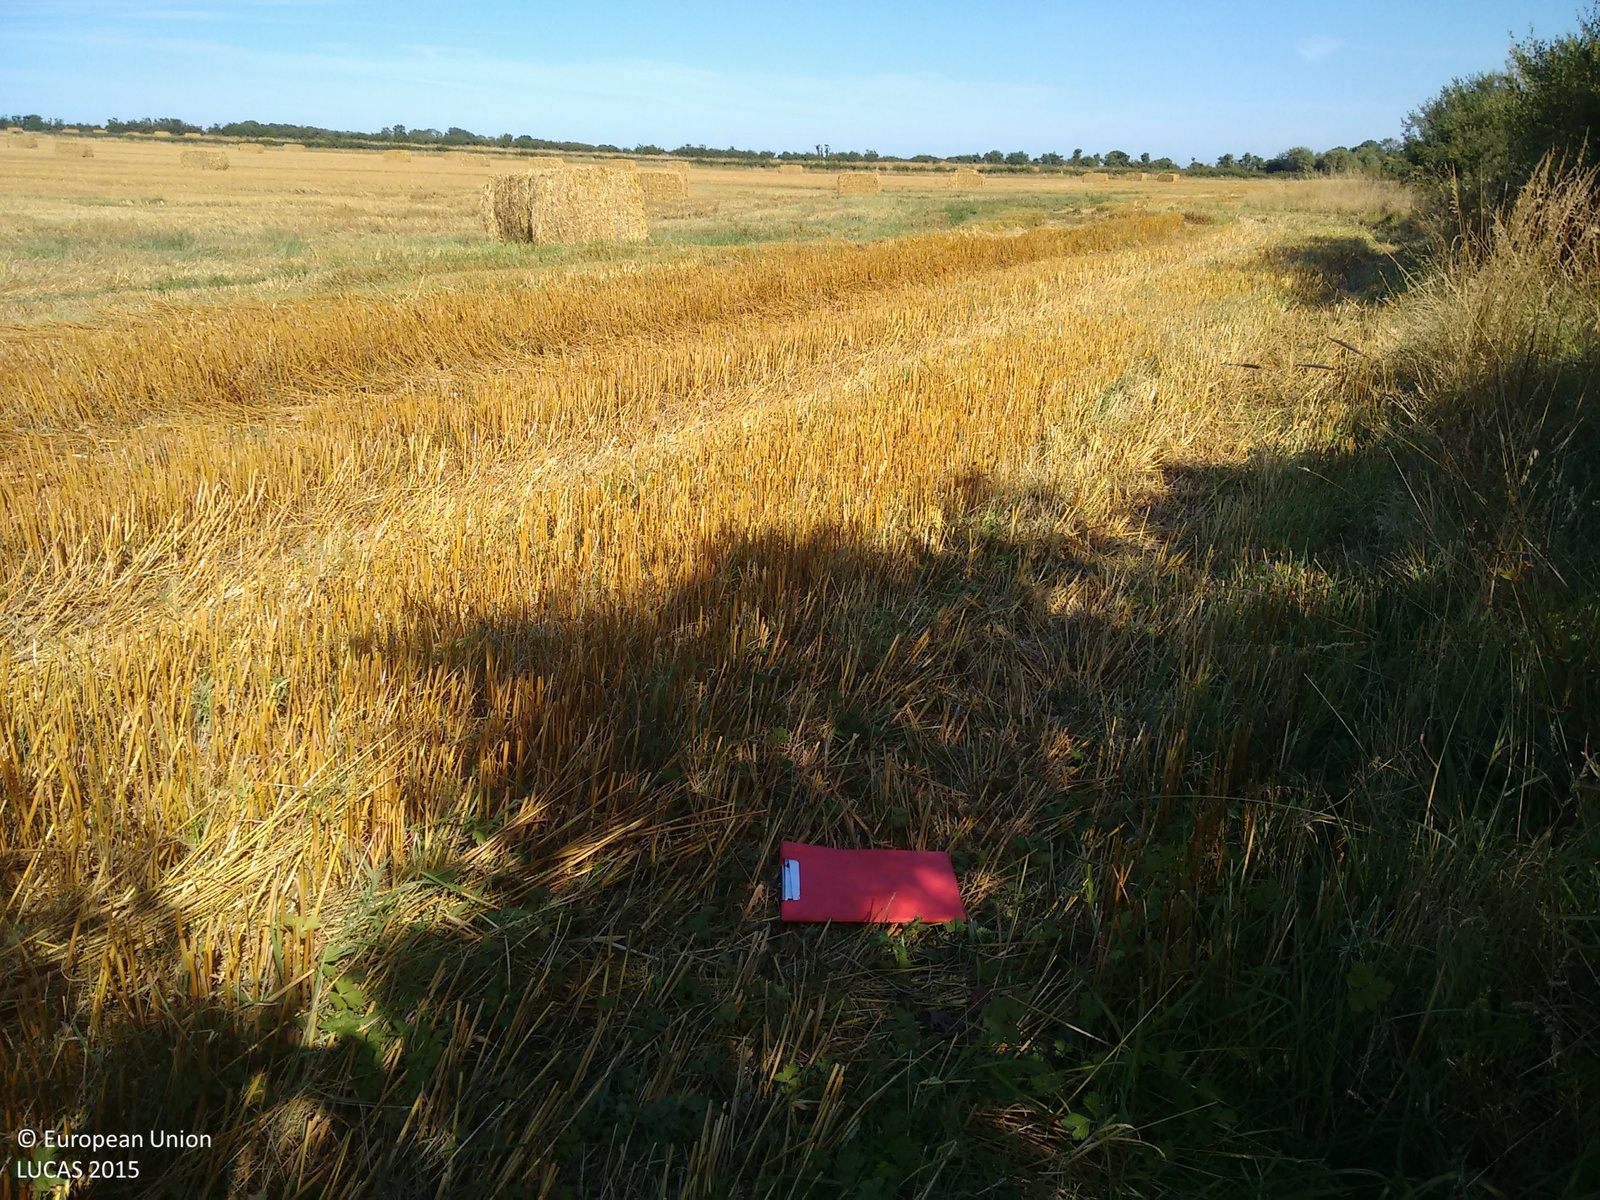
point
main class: Cropland
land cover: Oats
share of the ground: > 75 %
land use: Agriculture (excluding fallow land and kitchen gardens)
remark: Harvested field
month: August
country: IE
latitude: 53.8509
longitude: -6.2785
